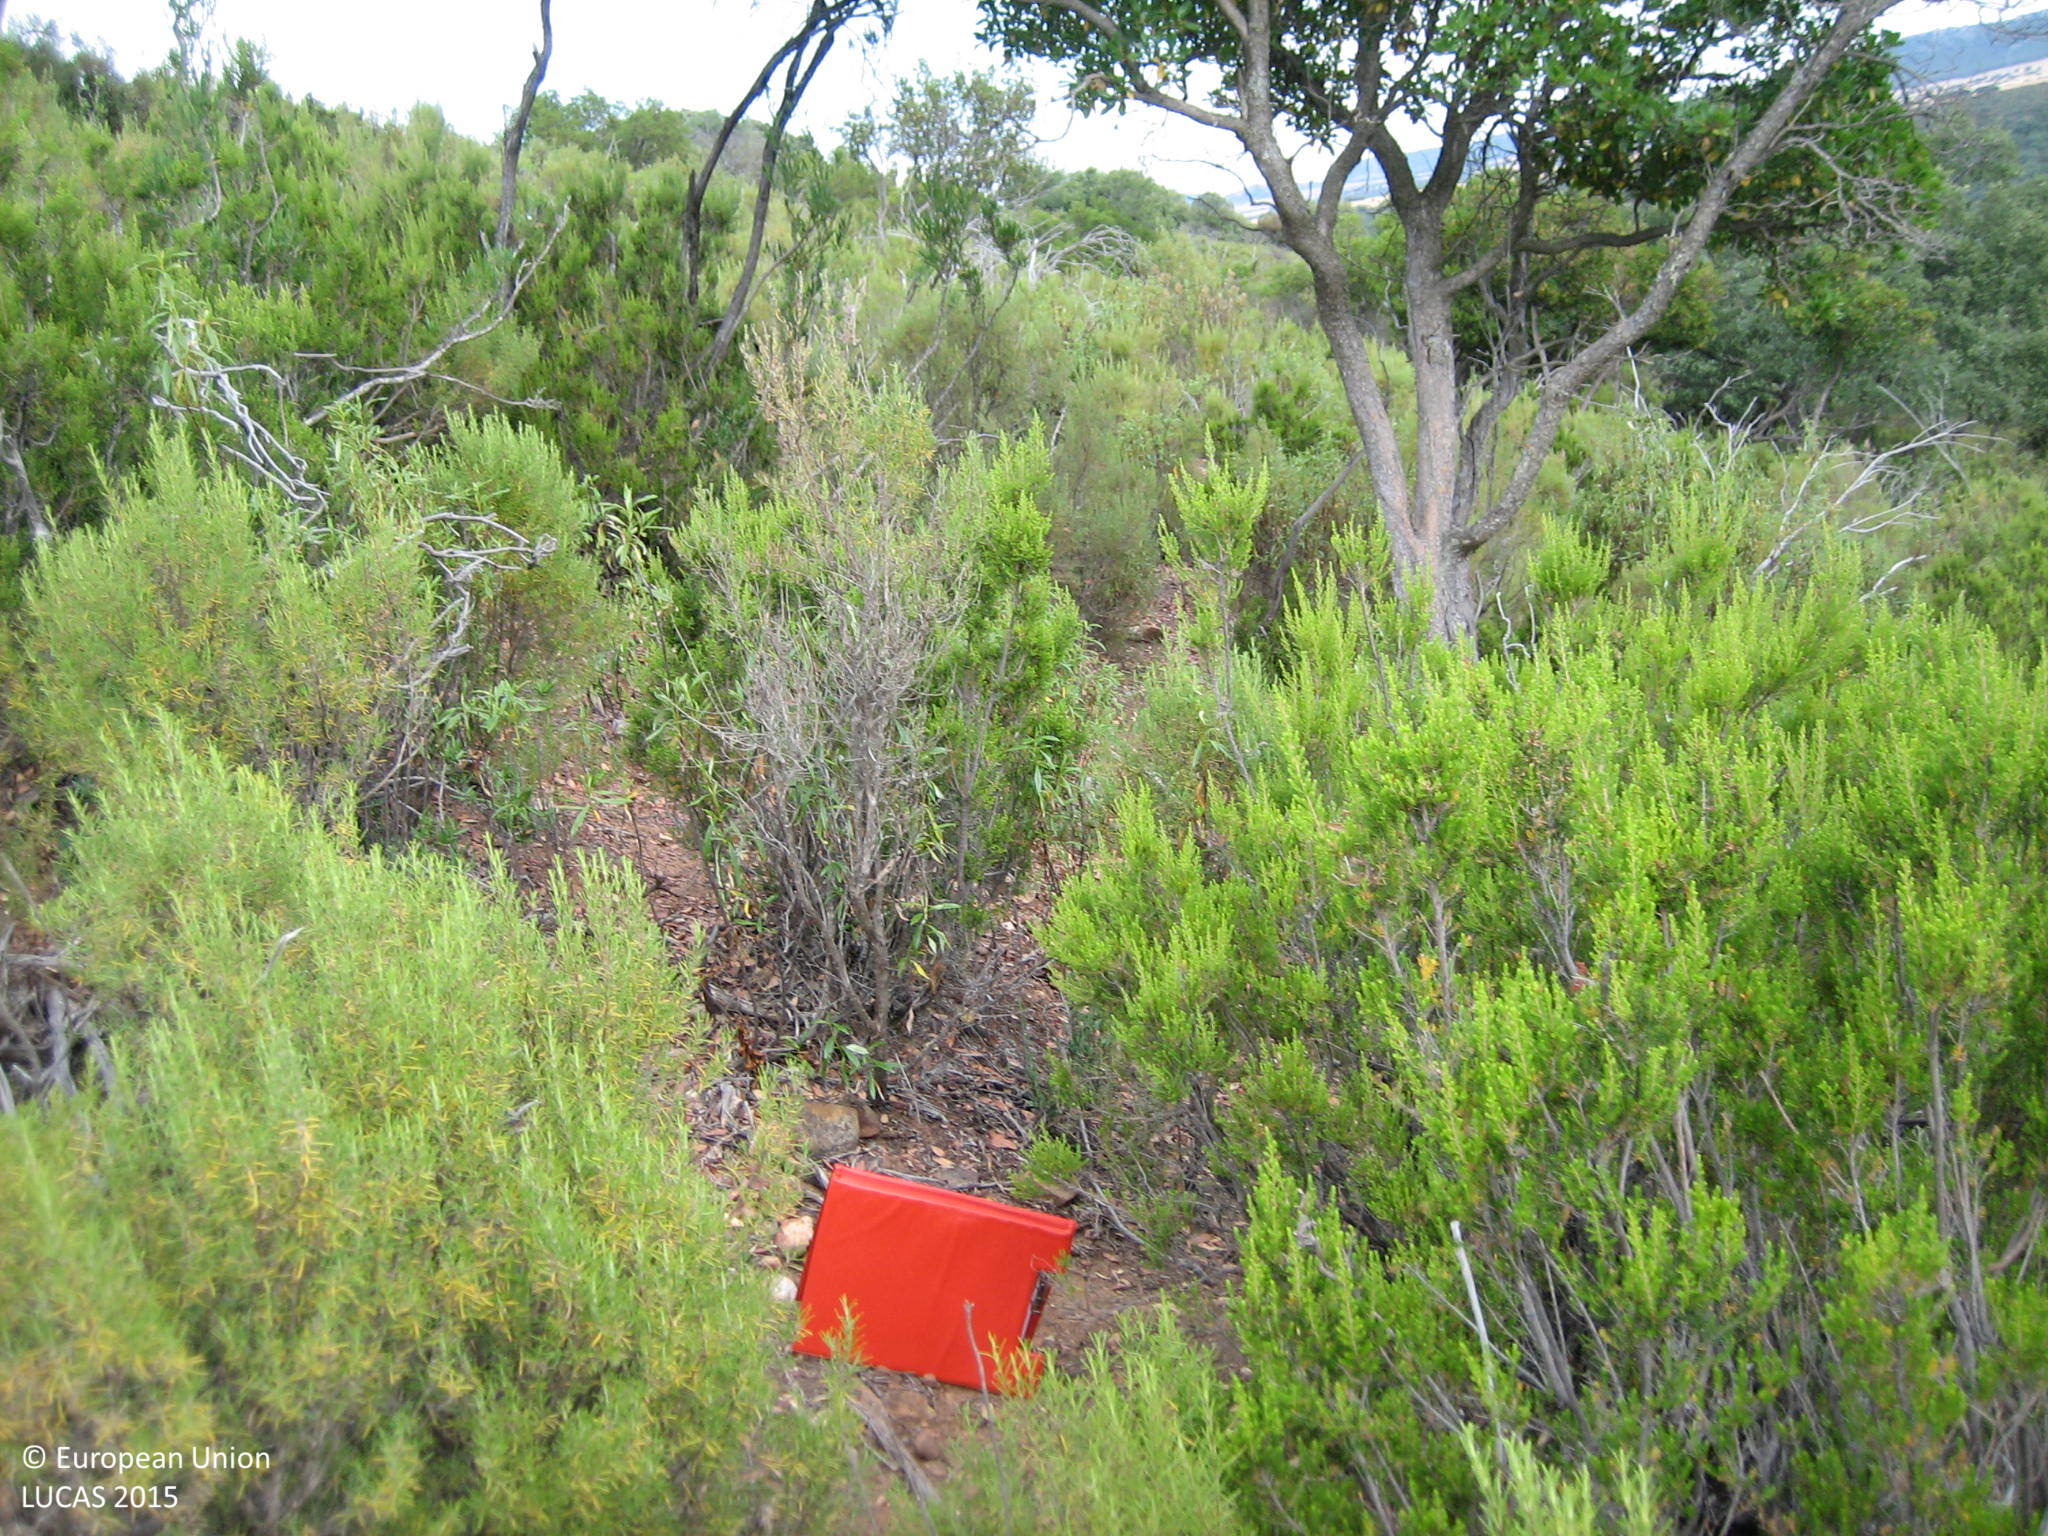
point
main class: Shrubland
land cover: Shrubland with sparse tree cover
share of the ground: > 75 %
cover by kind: shrubs 90 %, broadleaved forest trees 5 %, herbaceous plants 5 %
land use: Semi-natural and natural areas not in use
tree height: > 5 m
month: June
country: ES
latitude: 39.1294
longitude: -4.7364
